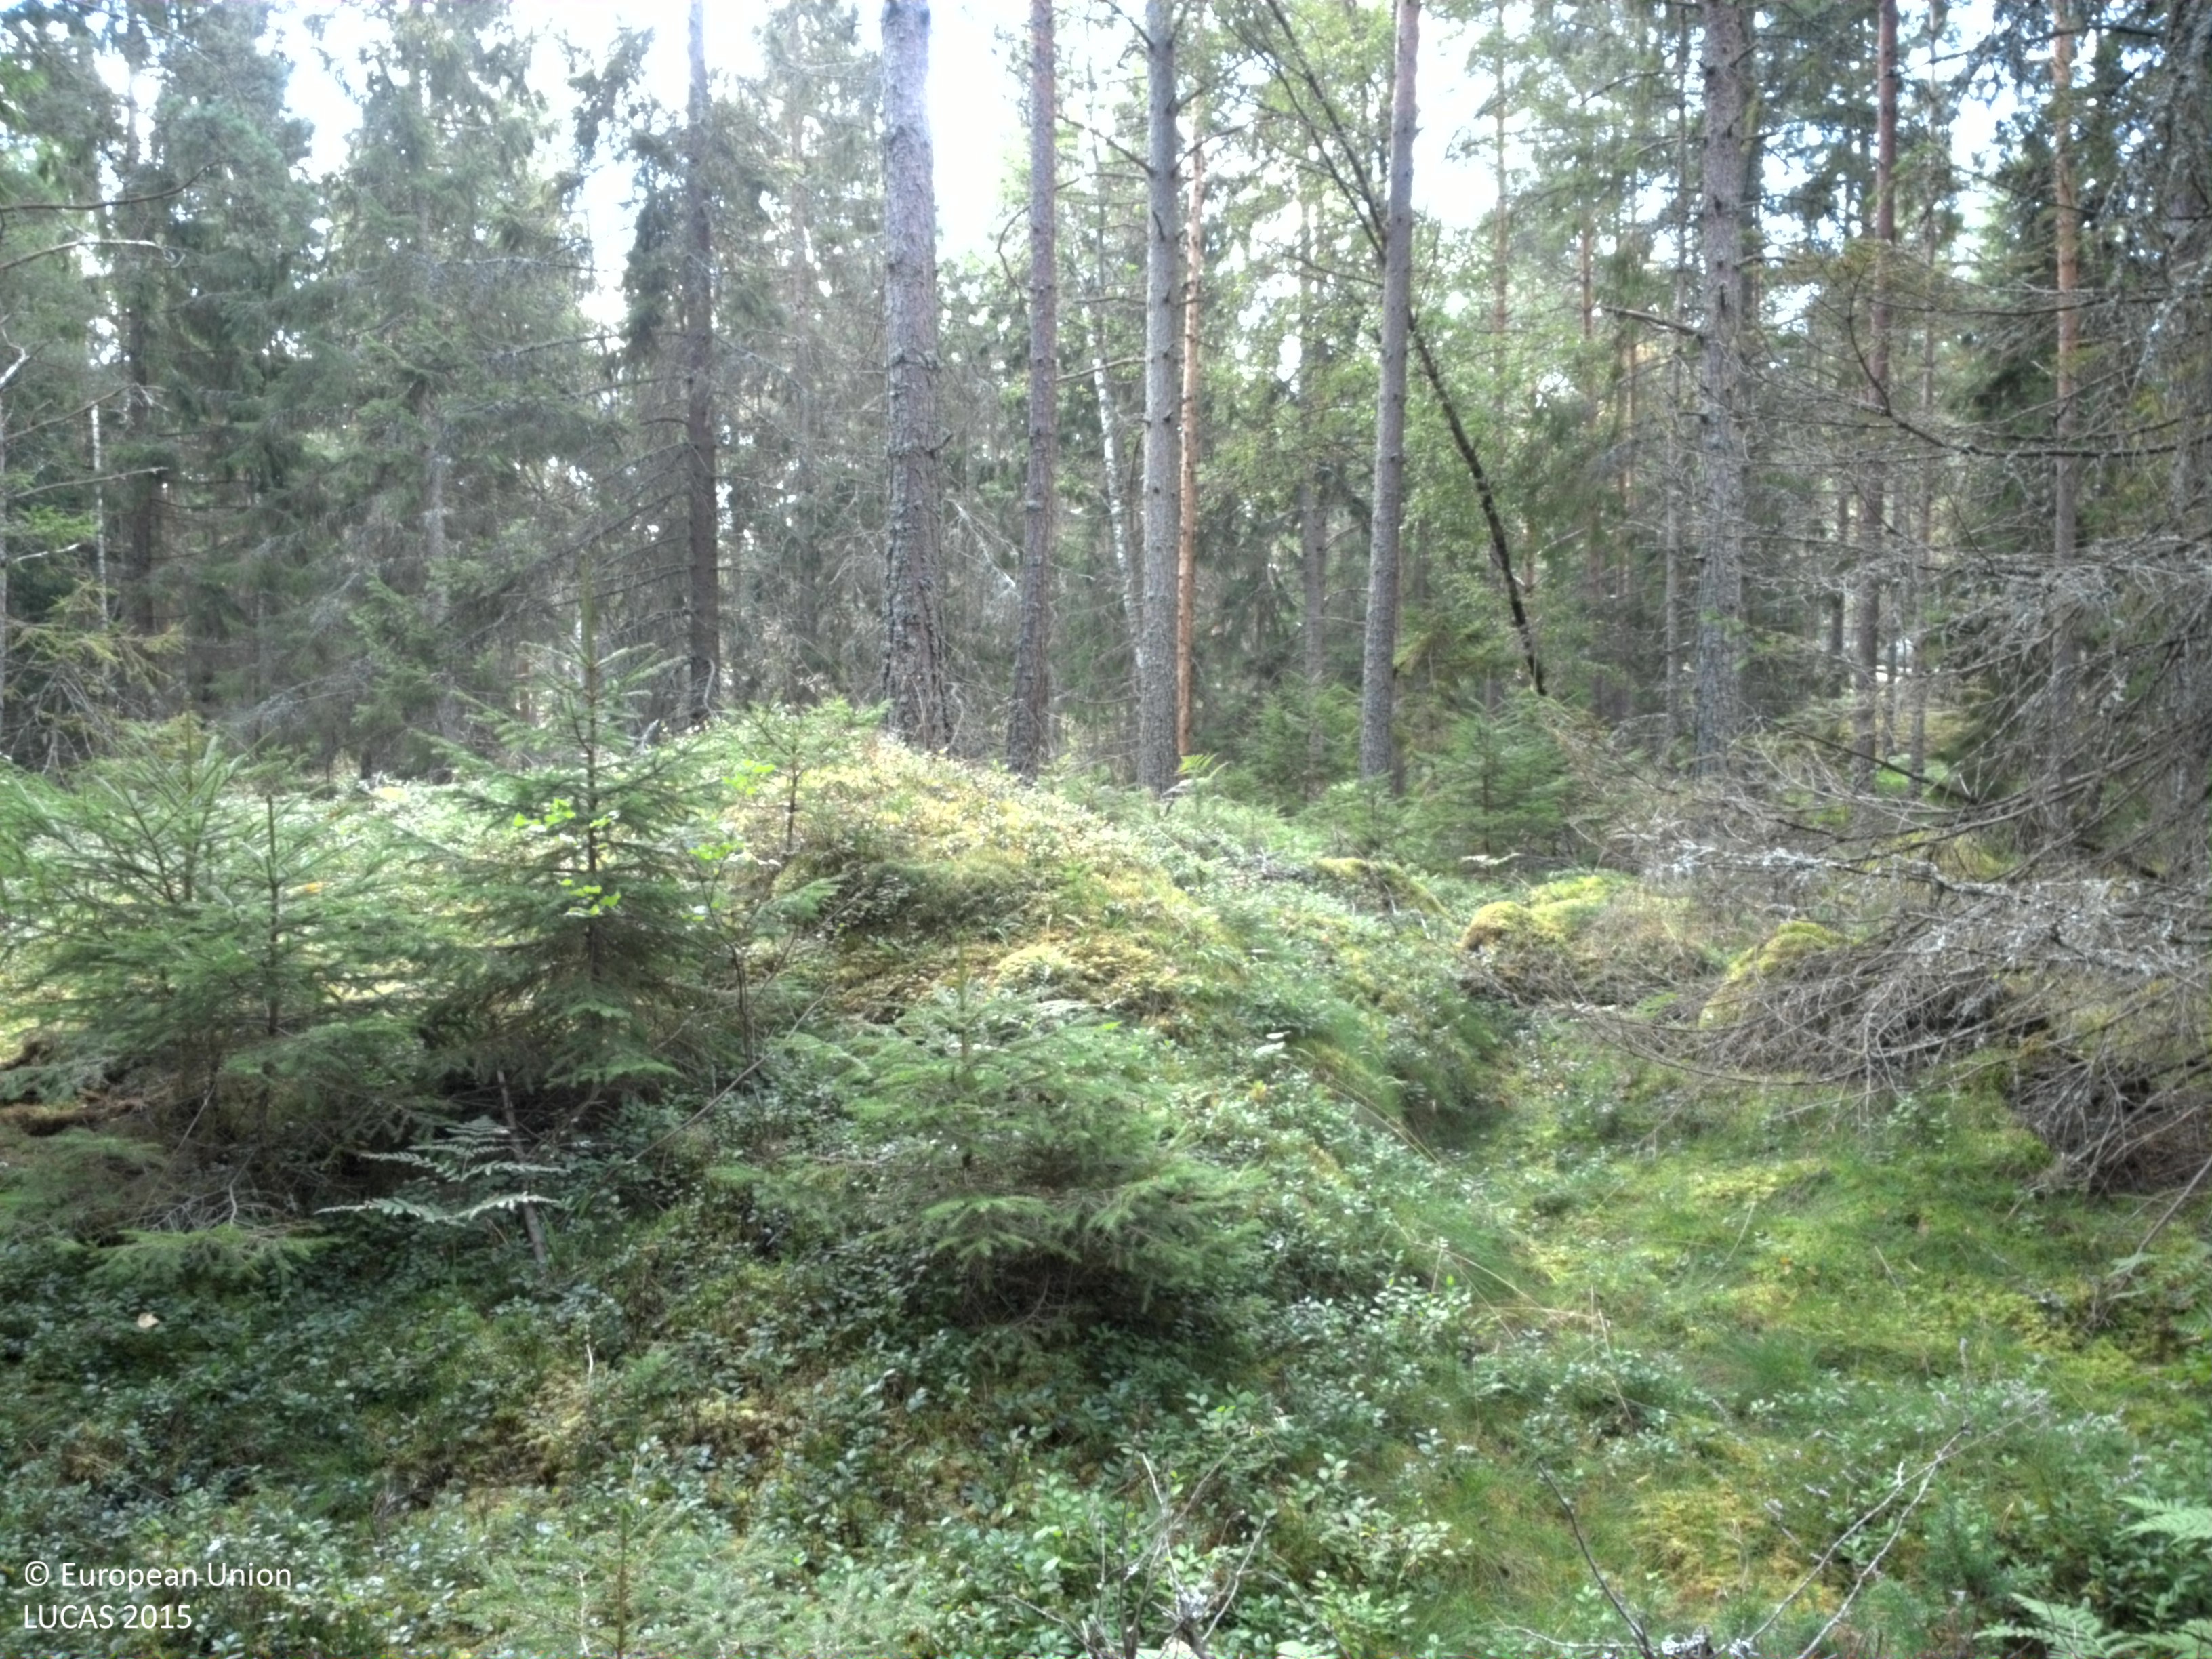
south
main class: Woodland
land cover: Spruce dominated coniferous woodland
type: boreal forest
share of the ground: > 75 %
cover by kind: coniferous forest trees 70 %, lichens and mosses 20 %, broadleaved forest trees 10 %
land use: Forestry
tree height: > 5 m
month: August
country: SE
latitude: 59.5826
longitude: 17.1655
